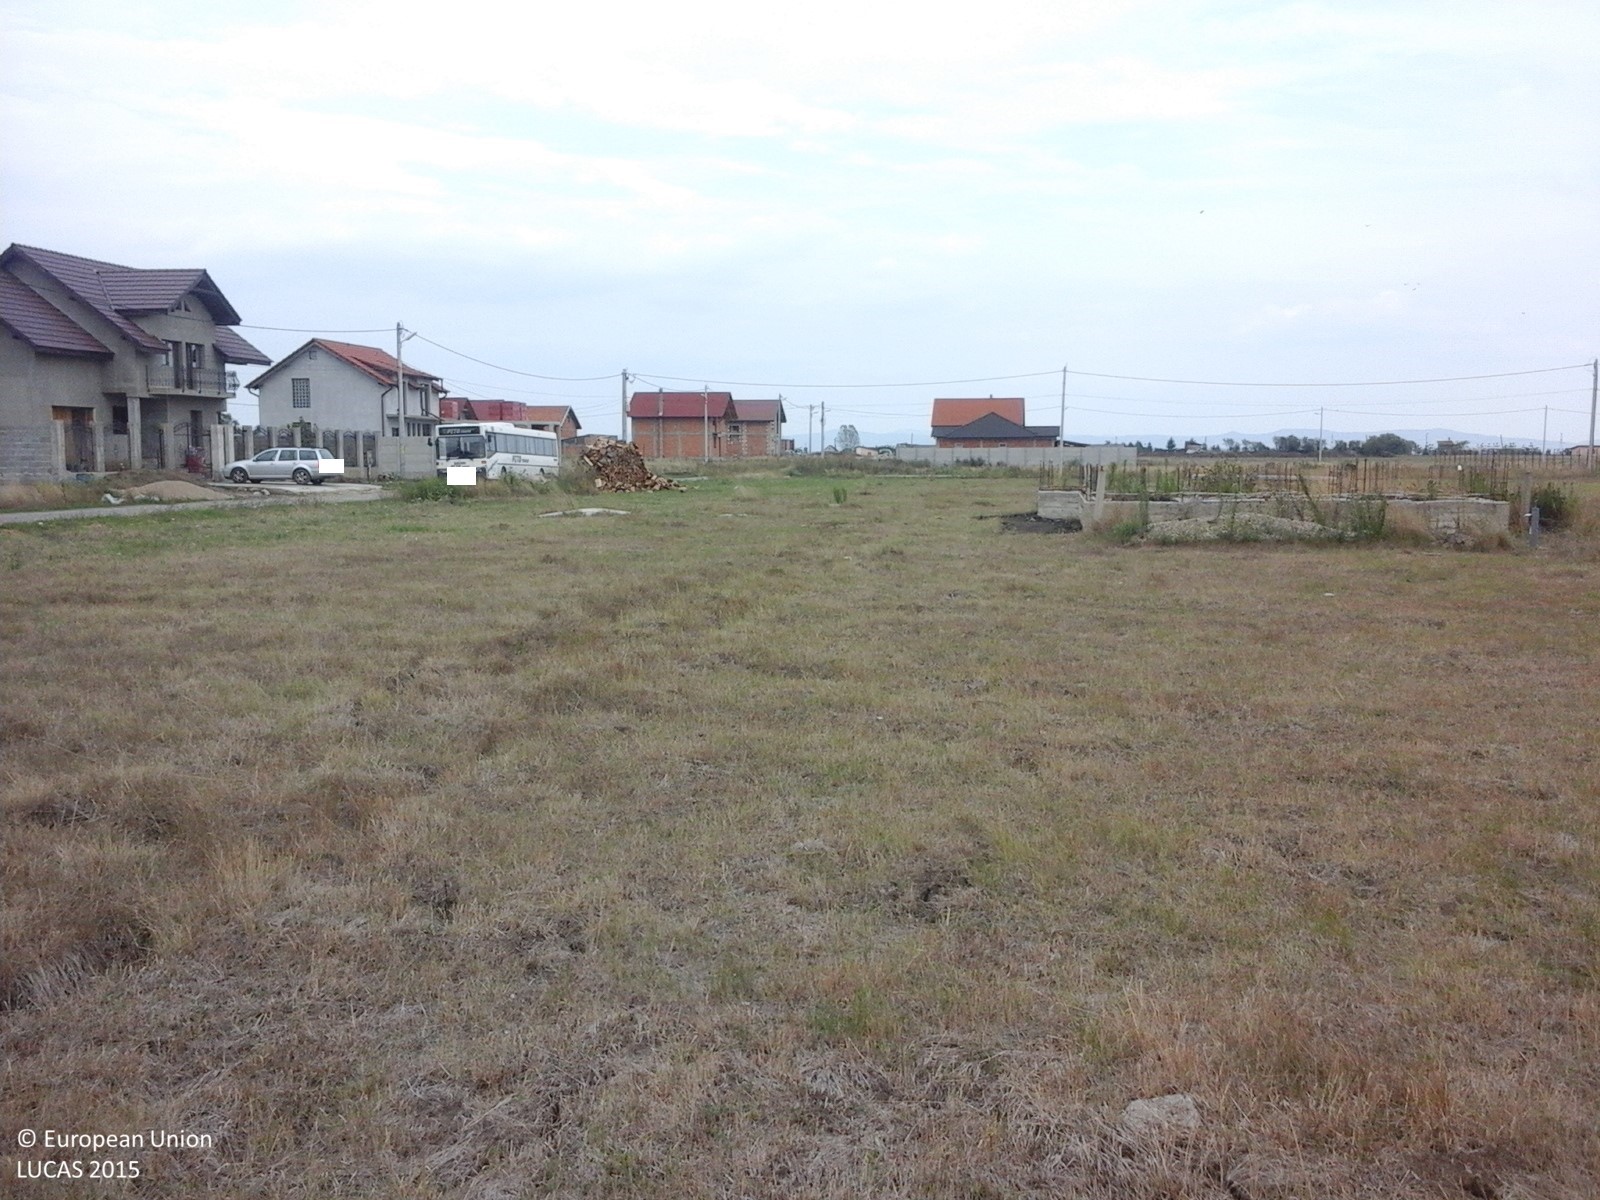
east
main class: Grassland
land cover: Grassland without tree/shrub cover
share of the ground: > 75 %
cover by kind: herbaceous plants 100 %
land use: Residential
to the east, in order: Grassland without tree/shrub cover; Paved roads, cycling and walking lanes; Electric lines; Tracks; Spontaneously vegetated surfaces; Electric lines; Spontaneously vegetated surfaces; Artificial constructions in urban areas; Spontaneously vegetated surfaces; Grassland without tree/shrub cover
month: August
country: RO
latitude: 46.2503
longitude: 21.3847
